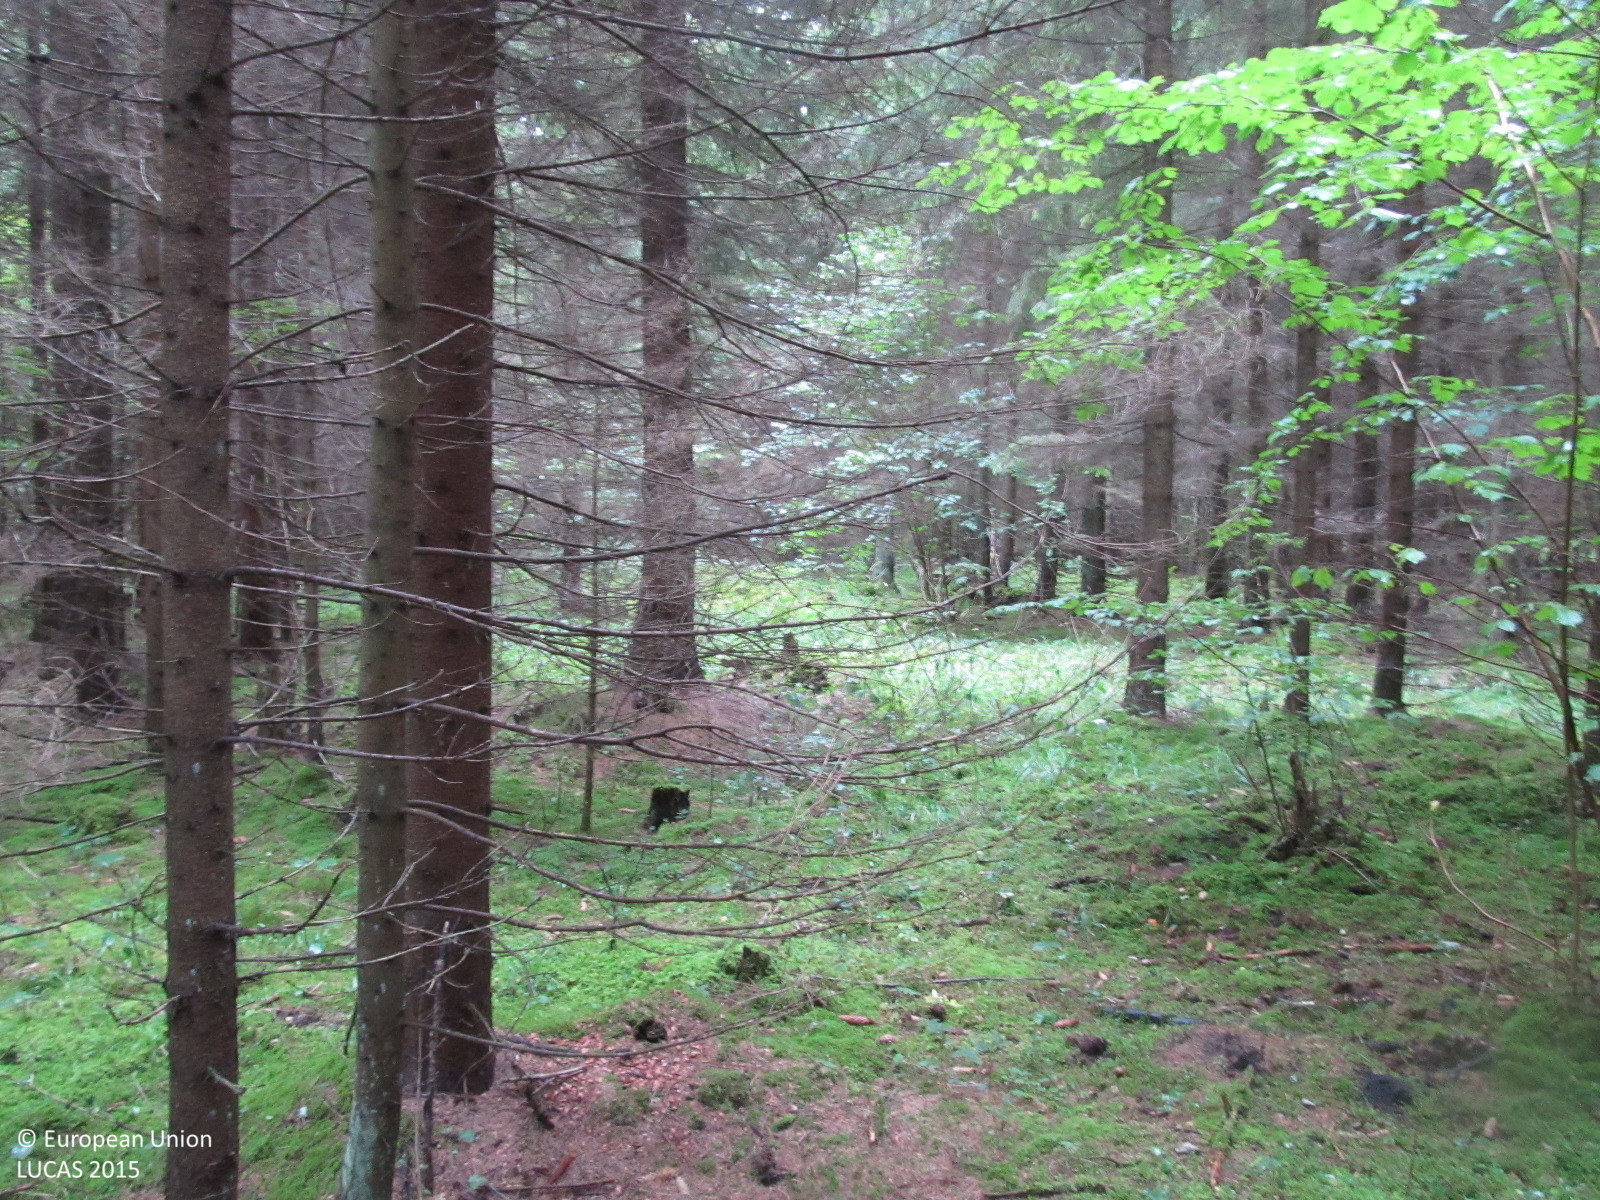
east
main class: Woodland
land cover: Spruce dominated coniferous woodland
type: hemiboreal forest and nemoral coniferous forest and mixed broadleaved-coniferous forest
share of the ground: > 75 %
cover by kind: coniferous forest trees 80 %, lichens and mosses 15 %, herbaceous plants 5 %
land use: Forestry
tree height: > 5 m
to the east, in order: Spruce dominated coniferous woodland; Tracks; Spruce dominated coniferous woodland; Other mixed woodland
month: September
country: LT
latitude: 56.0648
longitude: 23.2262
